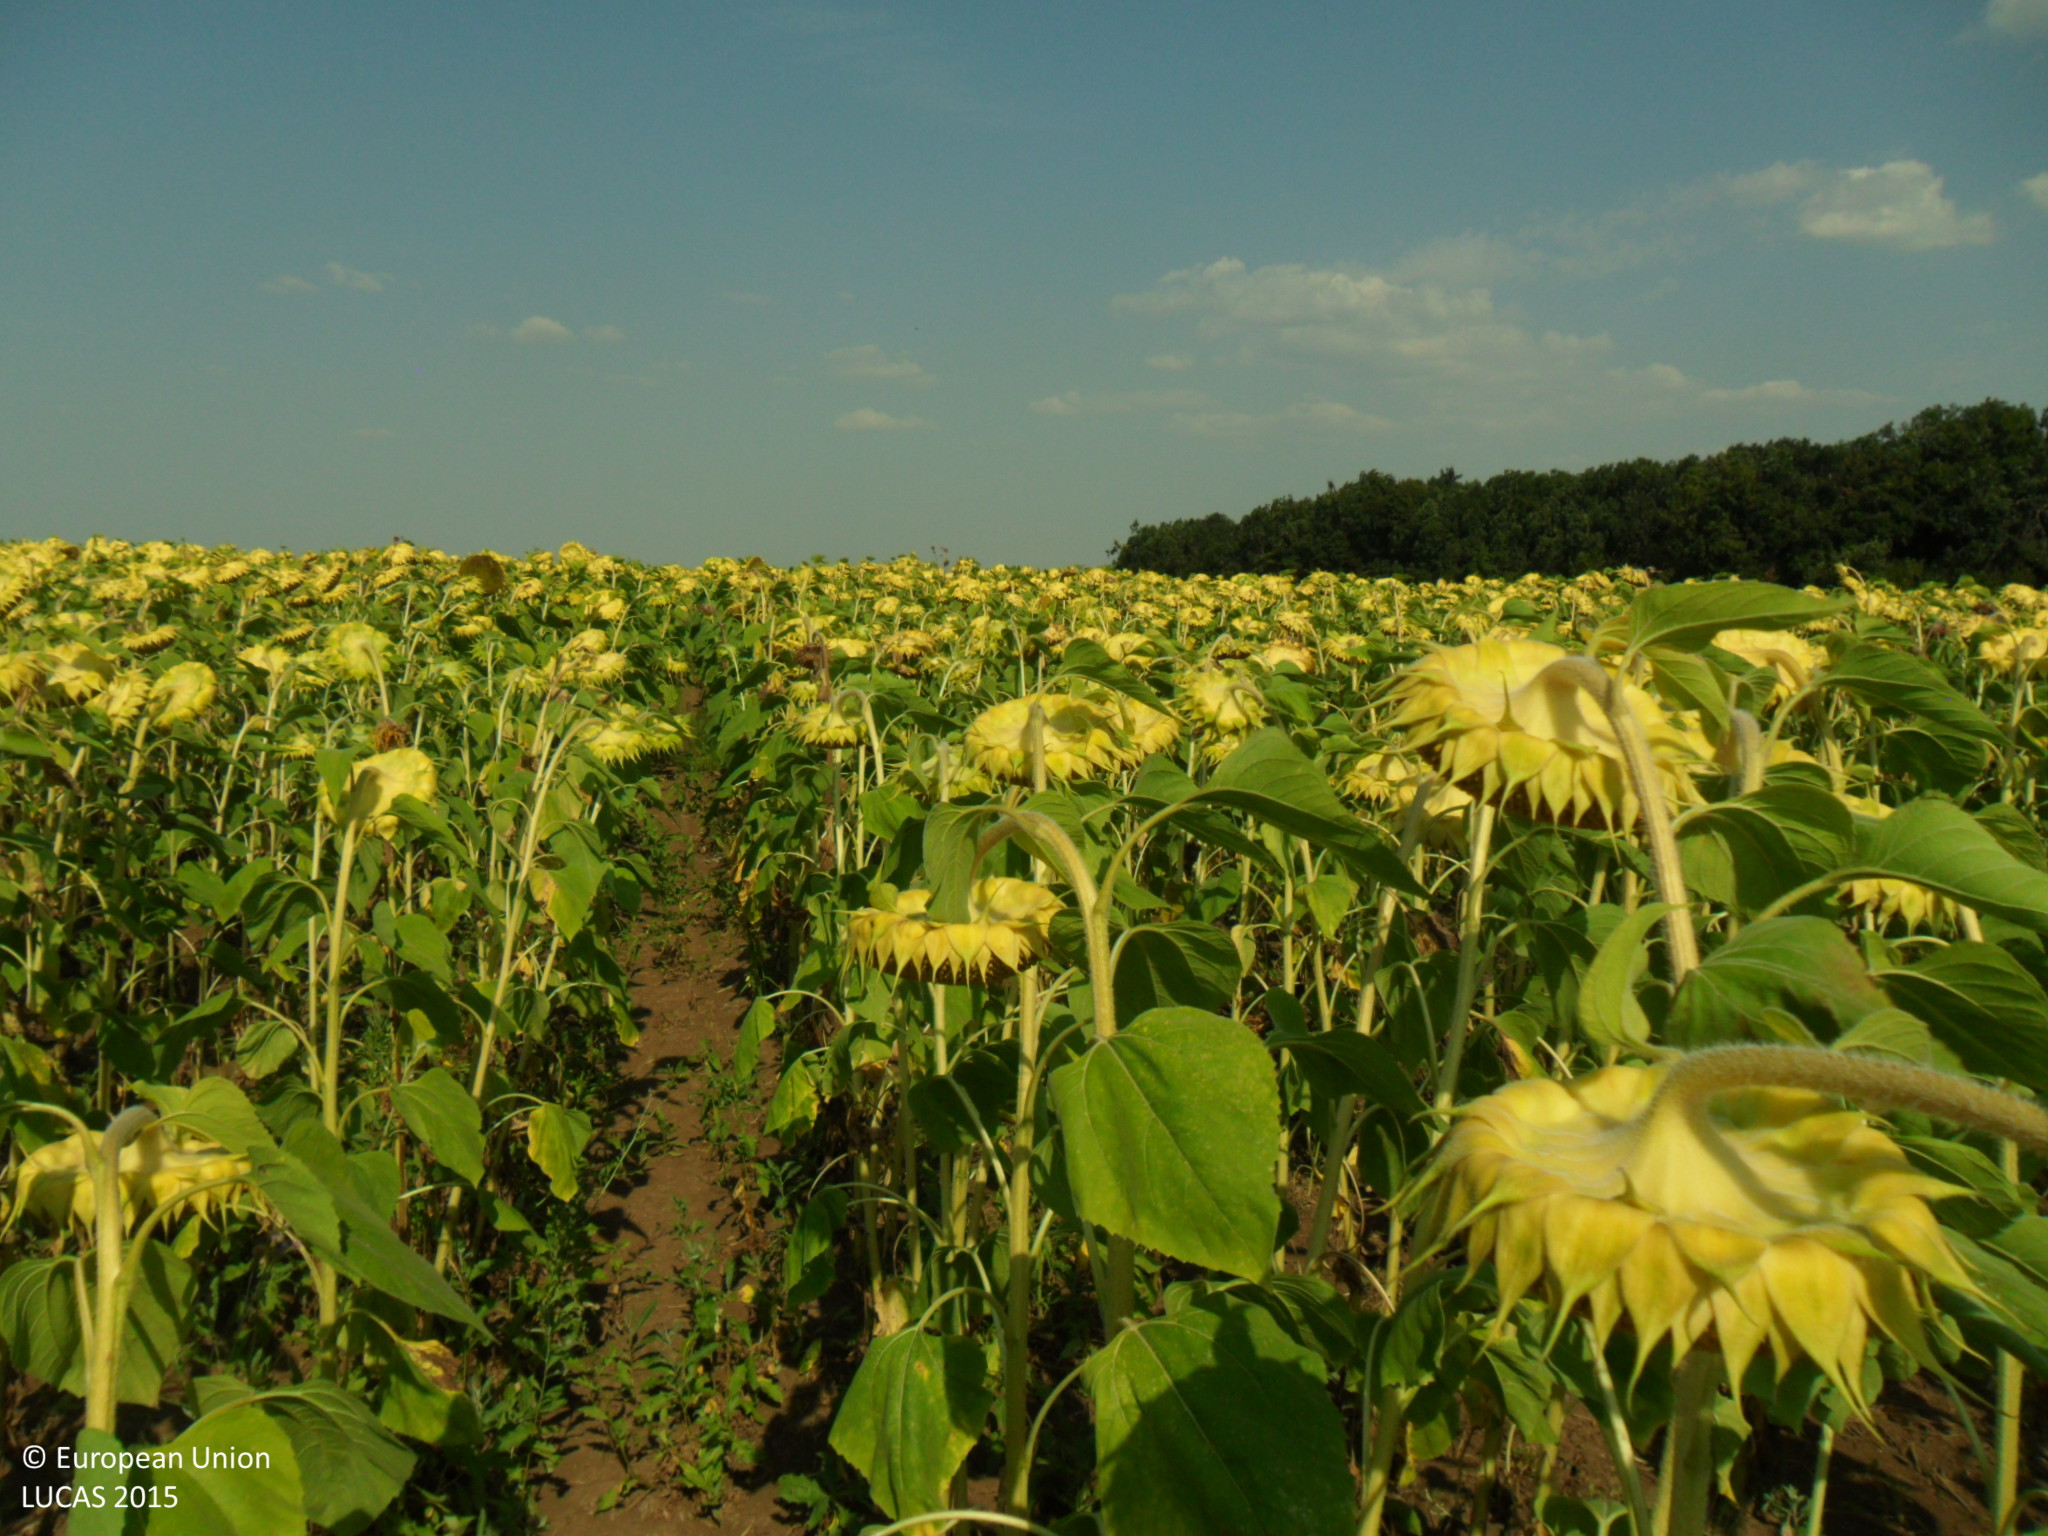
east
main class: Cropland
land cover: Sunflower
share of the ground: > 75 %
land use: Agriculture (excluding fallow land and kitchen gardens)
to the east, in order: Sunflower; Grass margins; Tracks; Broadleaved woodland
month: August
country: BG
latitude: 43.4295
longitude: 26.5723
